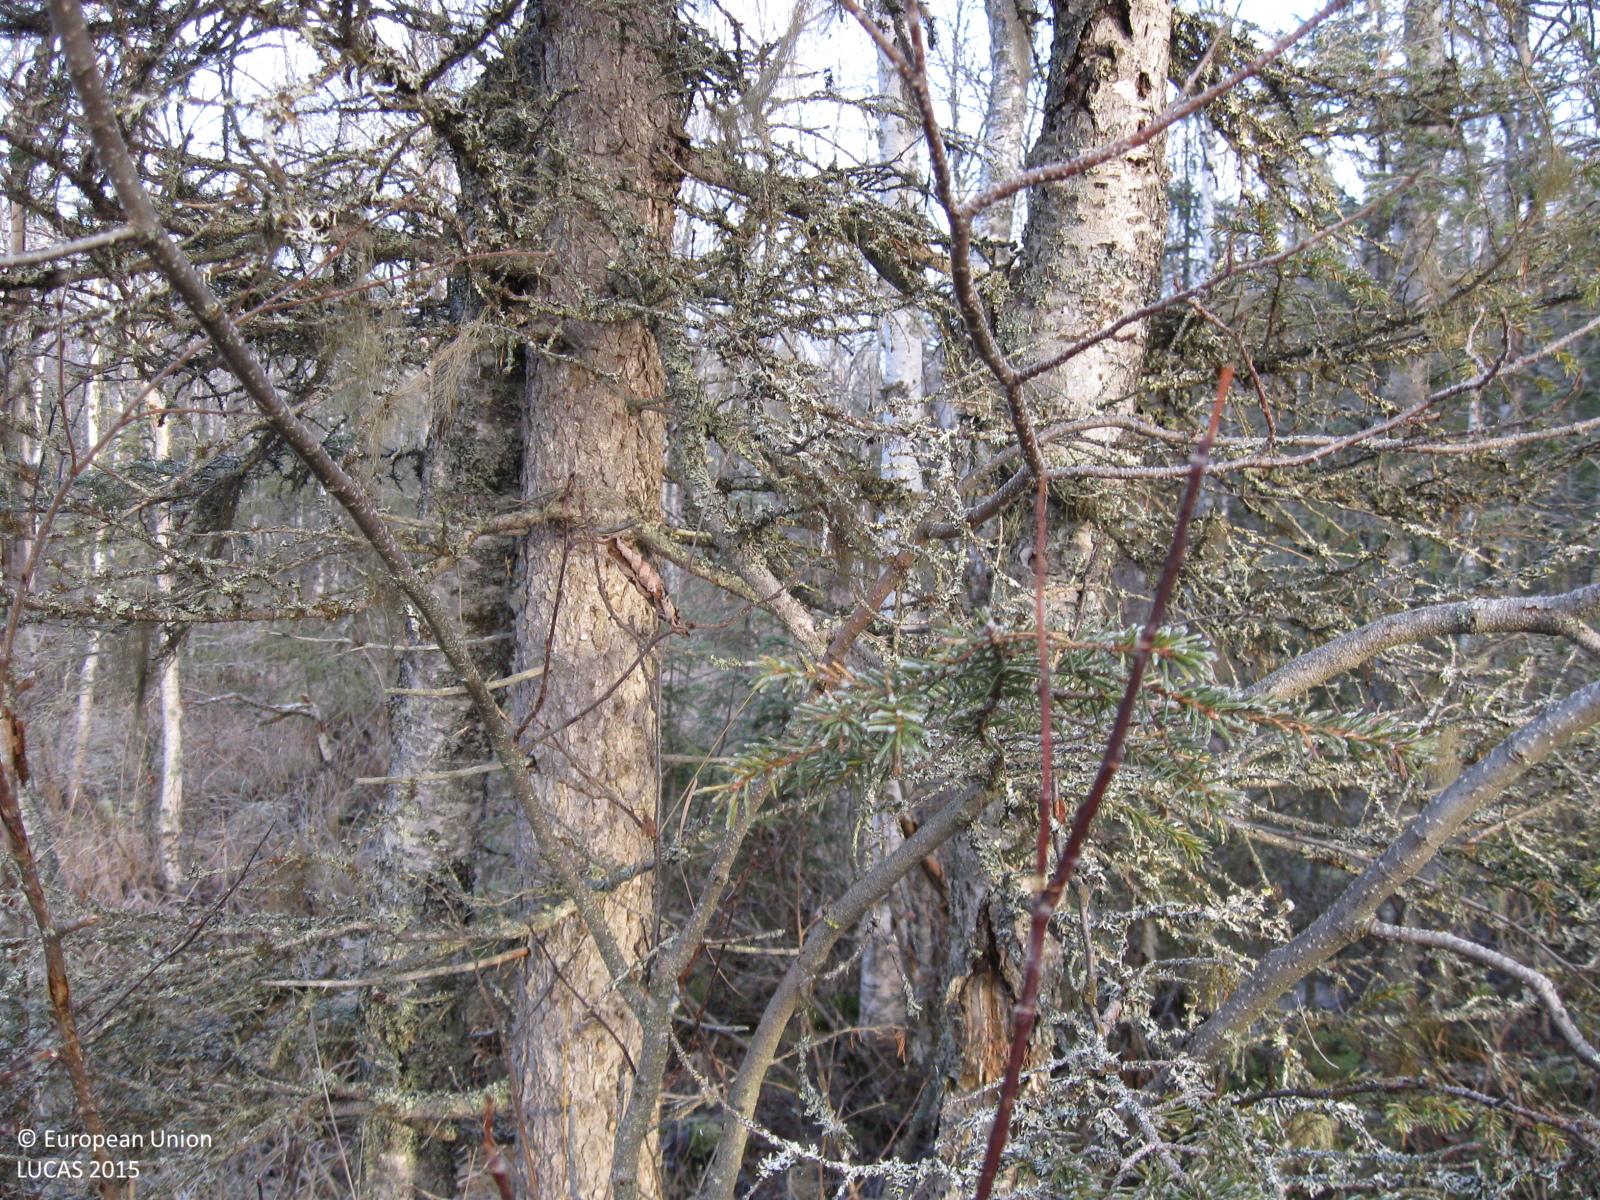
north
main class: Woodland
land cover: Spruce dominated mixed woodland
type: mire and swamp forests
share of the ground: > 75 %
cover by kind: broadleaved forest trees 50 %, coniferous forest trees 25 %, herbaceous plants 20 %, shrubs 5 %
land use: Semi-natural and natural areas not in use
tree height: > 5 m
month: October
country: SE
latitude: 66.0968
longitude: 21.5796
